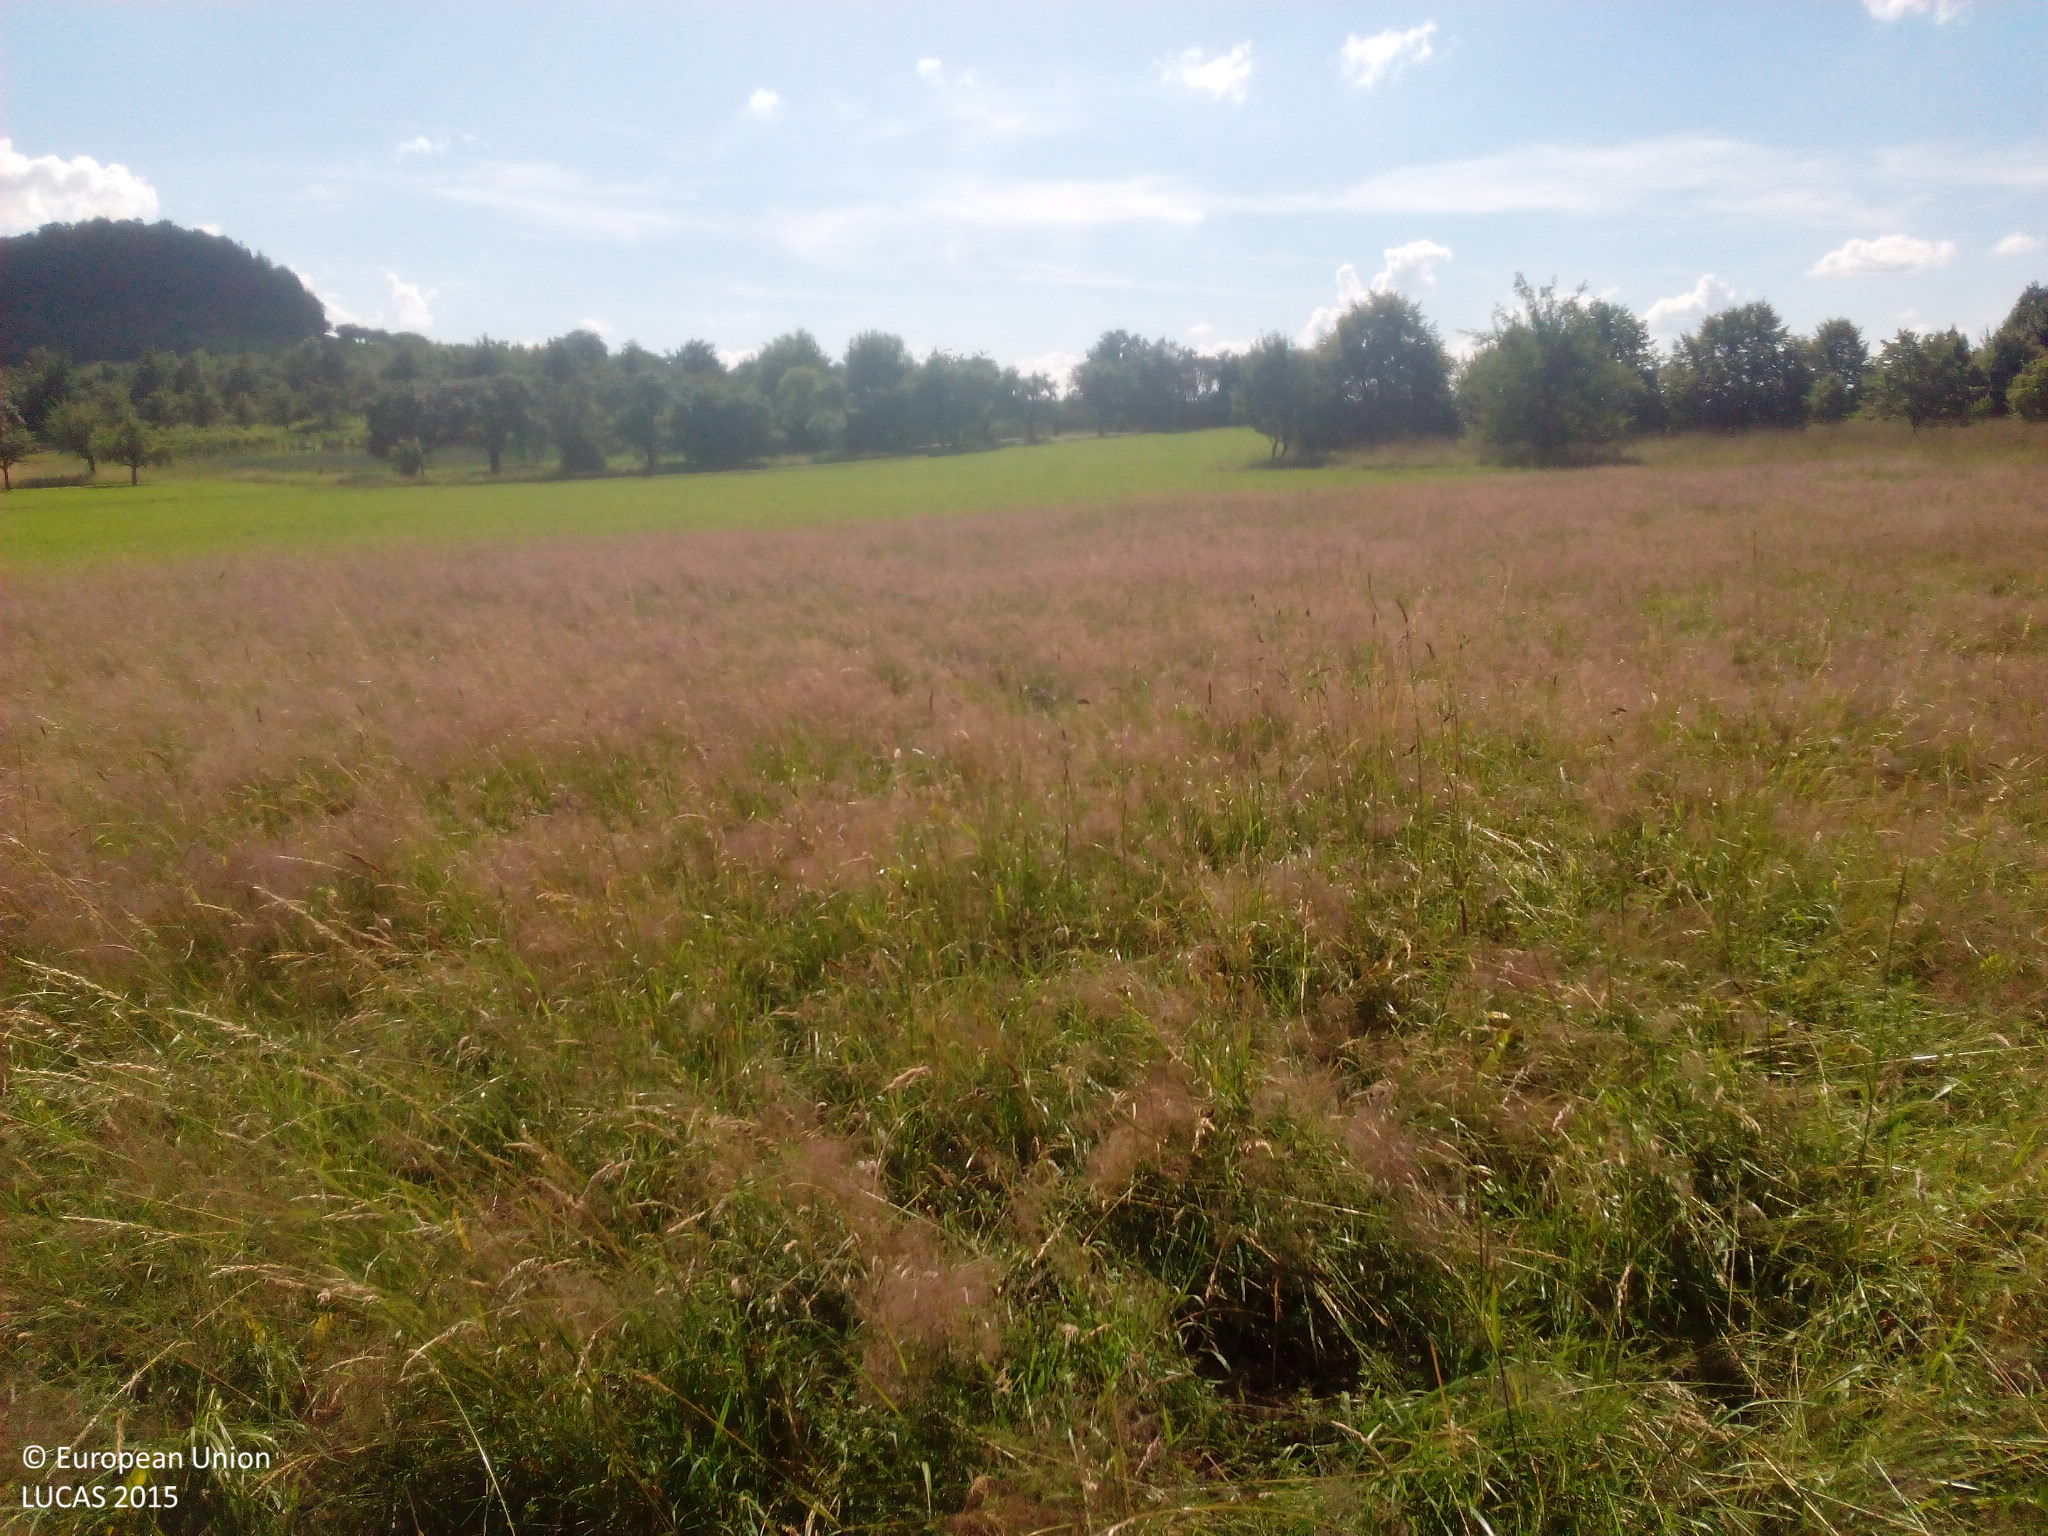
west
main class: Grassland
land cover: Grassland without tree/shrub cover
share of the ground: > 75 %
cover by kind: herbaceous plants 100 %
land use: Agriculture (excluding fallow land and kitchen gardens)
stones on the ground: < 10 %
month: June
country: DE
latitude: 48.5819
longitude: 9.4174
